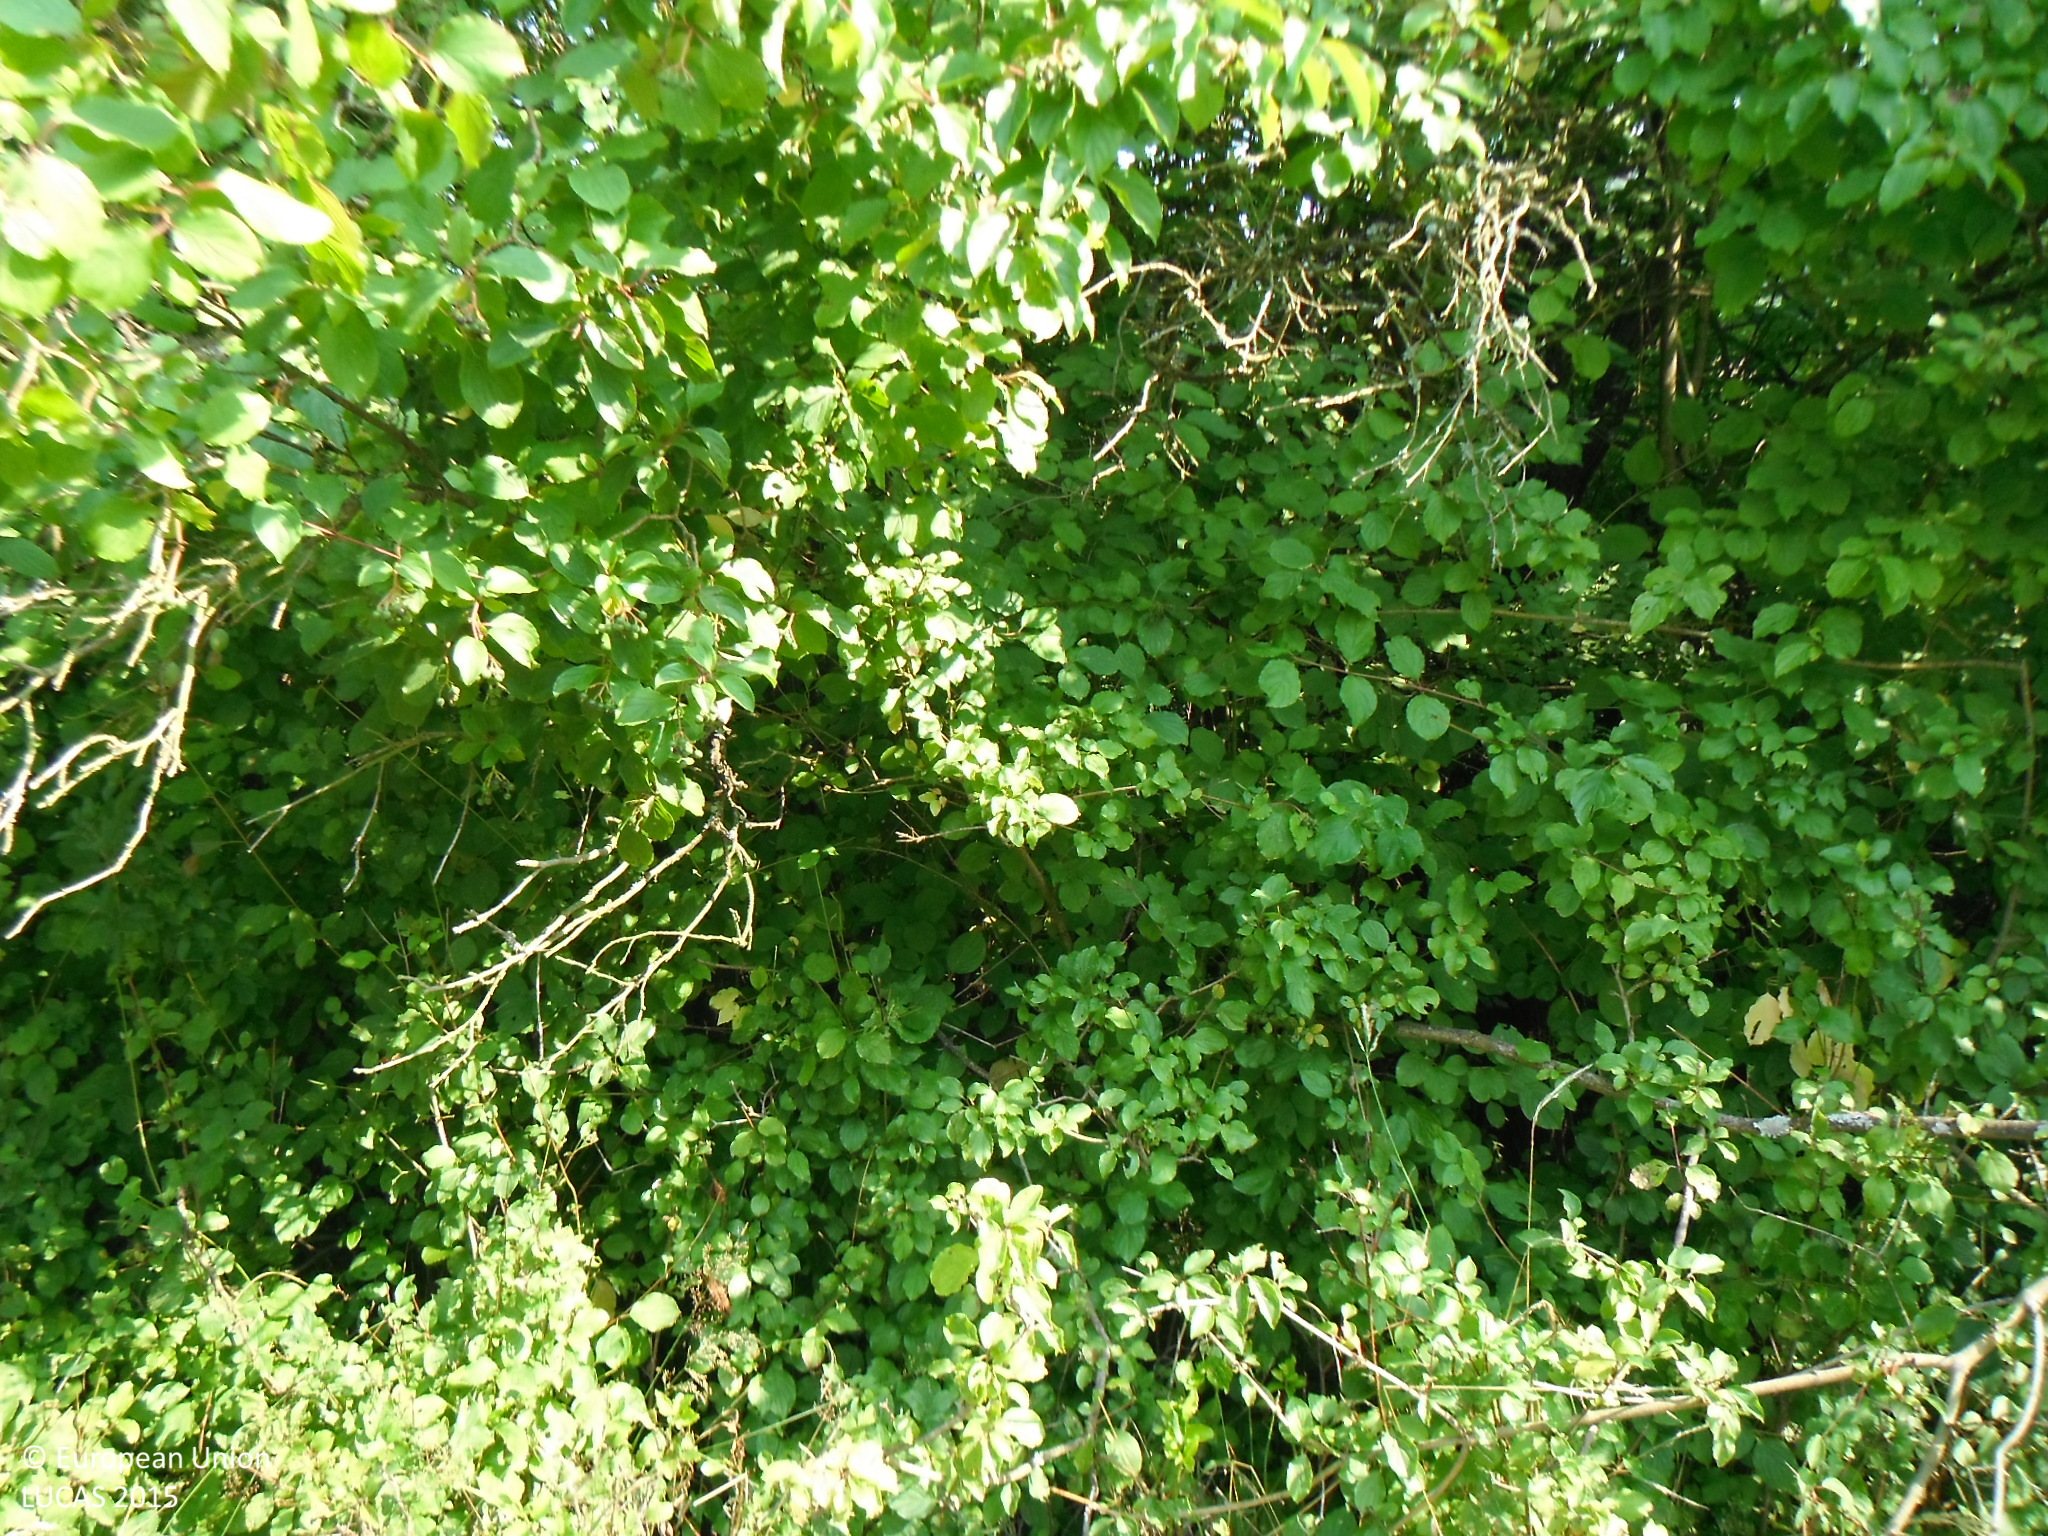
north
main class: Grassland
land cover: Grassland without tree/shrub cover
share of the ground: > 75 %
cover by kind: herbaceous plants 100 %
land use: Agriculture (excluding fallow land and kitchen gardens)
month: August
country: SK
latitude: 49.1332
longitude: 18.3913
